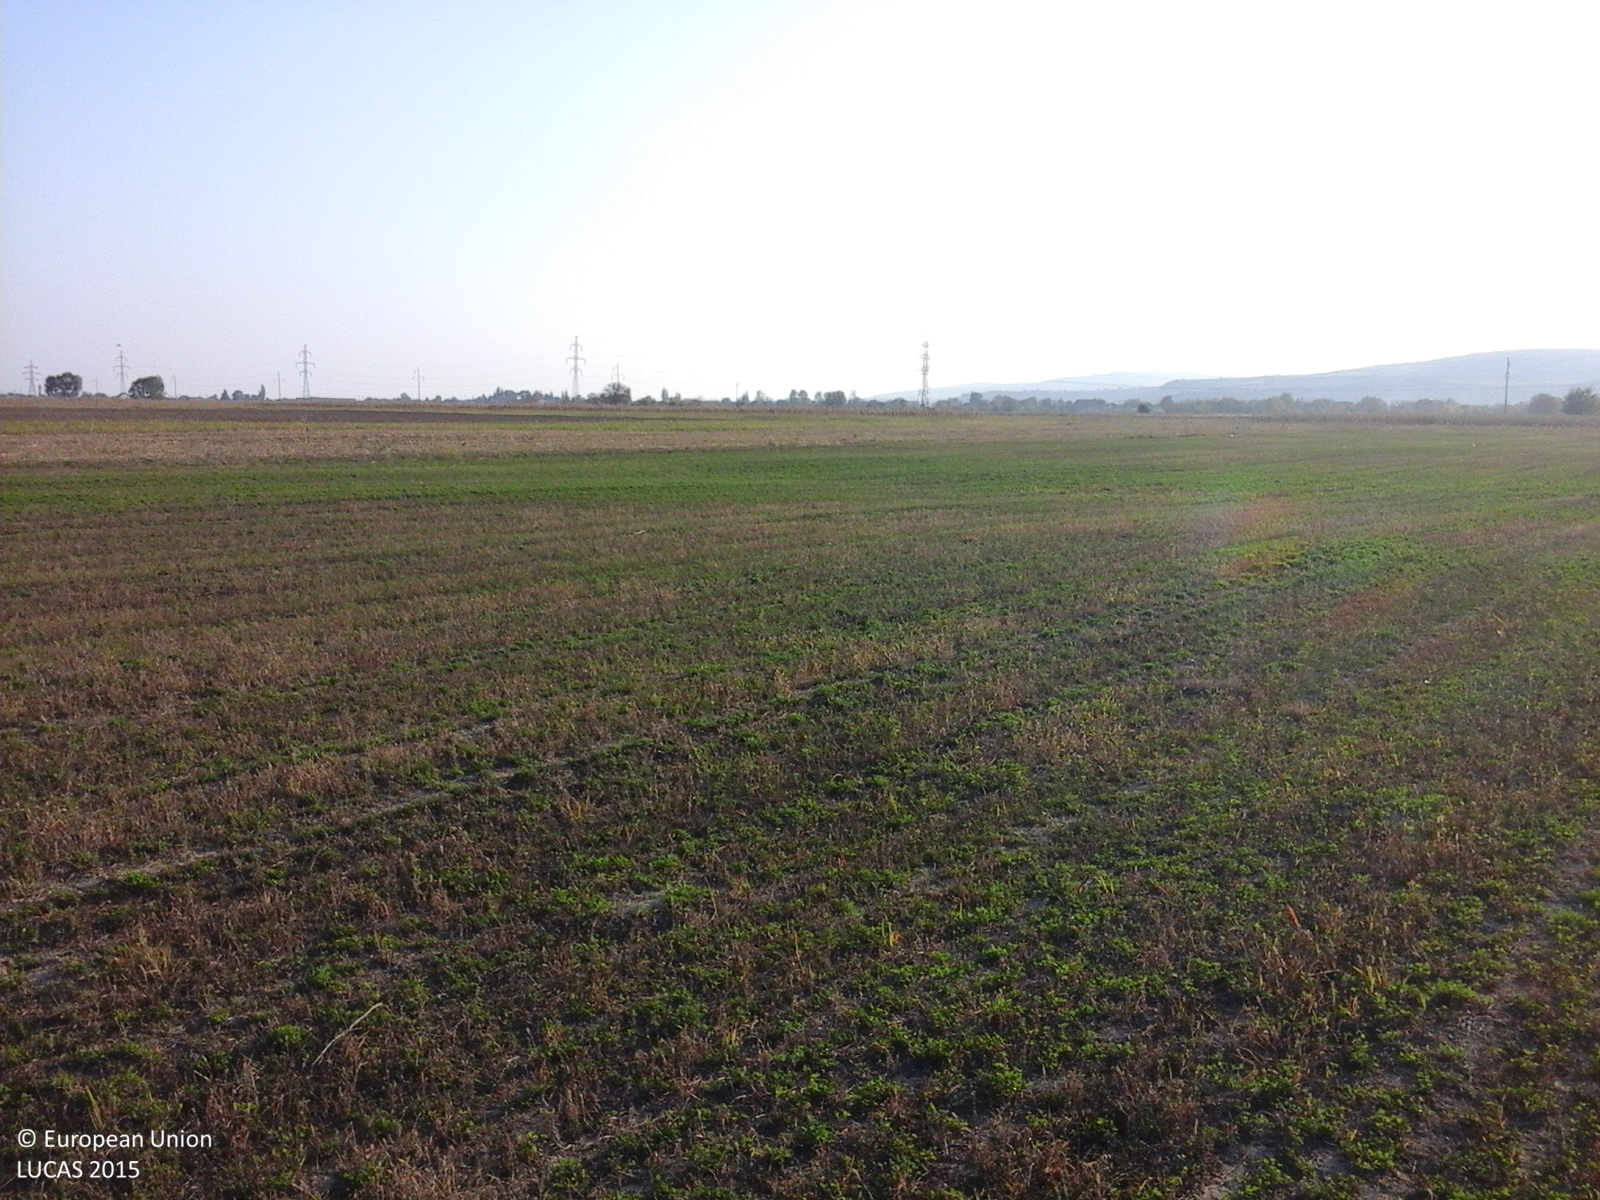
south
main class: Cropland
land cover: Lucerne
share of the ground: 50 - 75 %
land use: Agriculture (excluding fallow land and kitchen gardens)
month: October
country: RO
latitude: 45.2638
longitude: 26.7094
